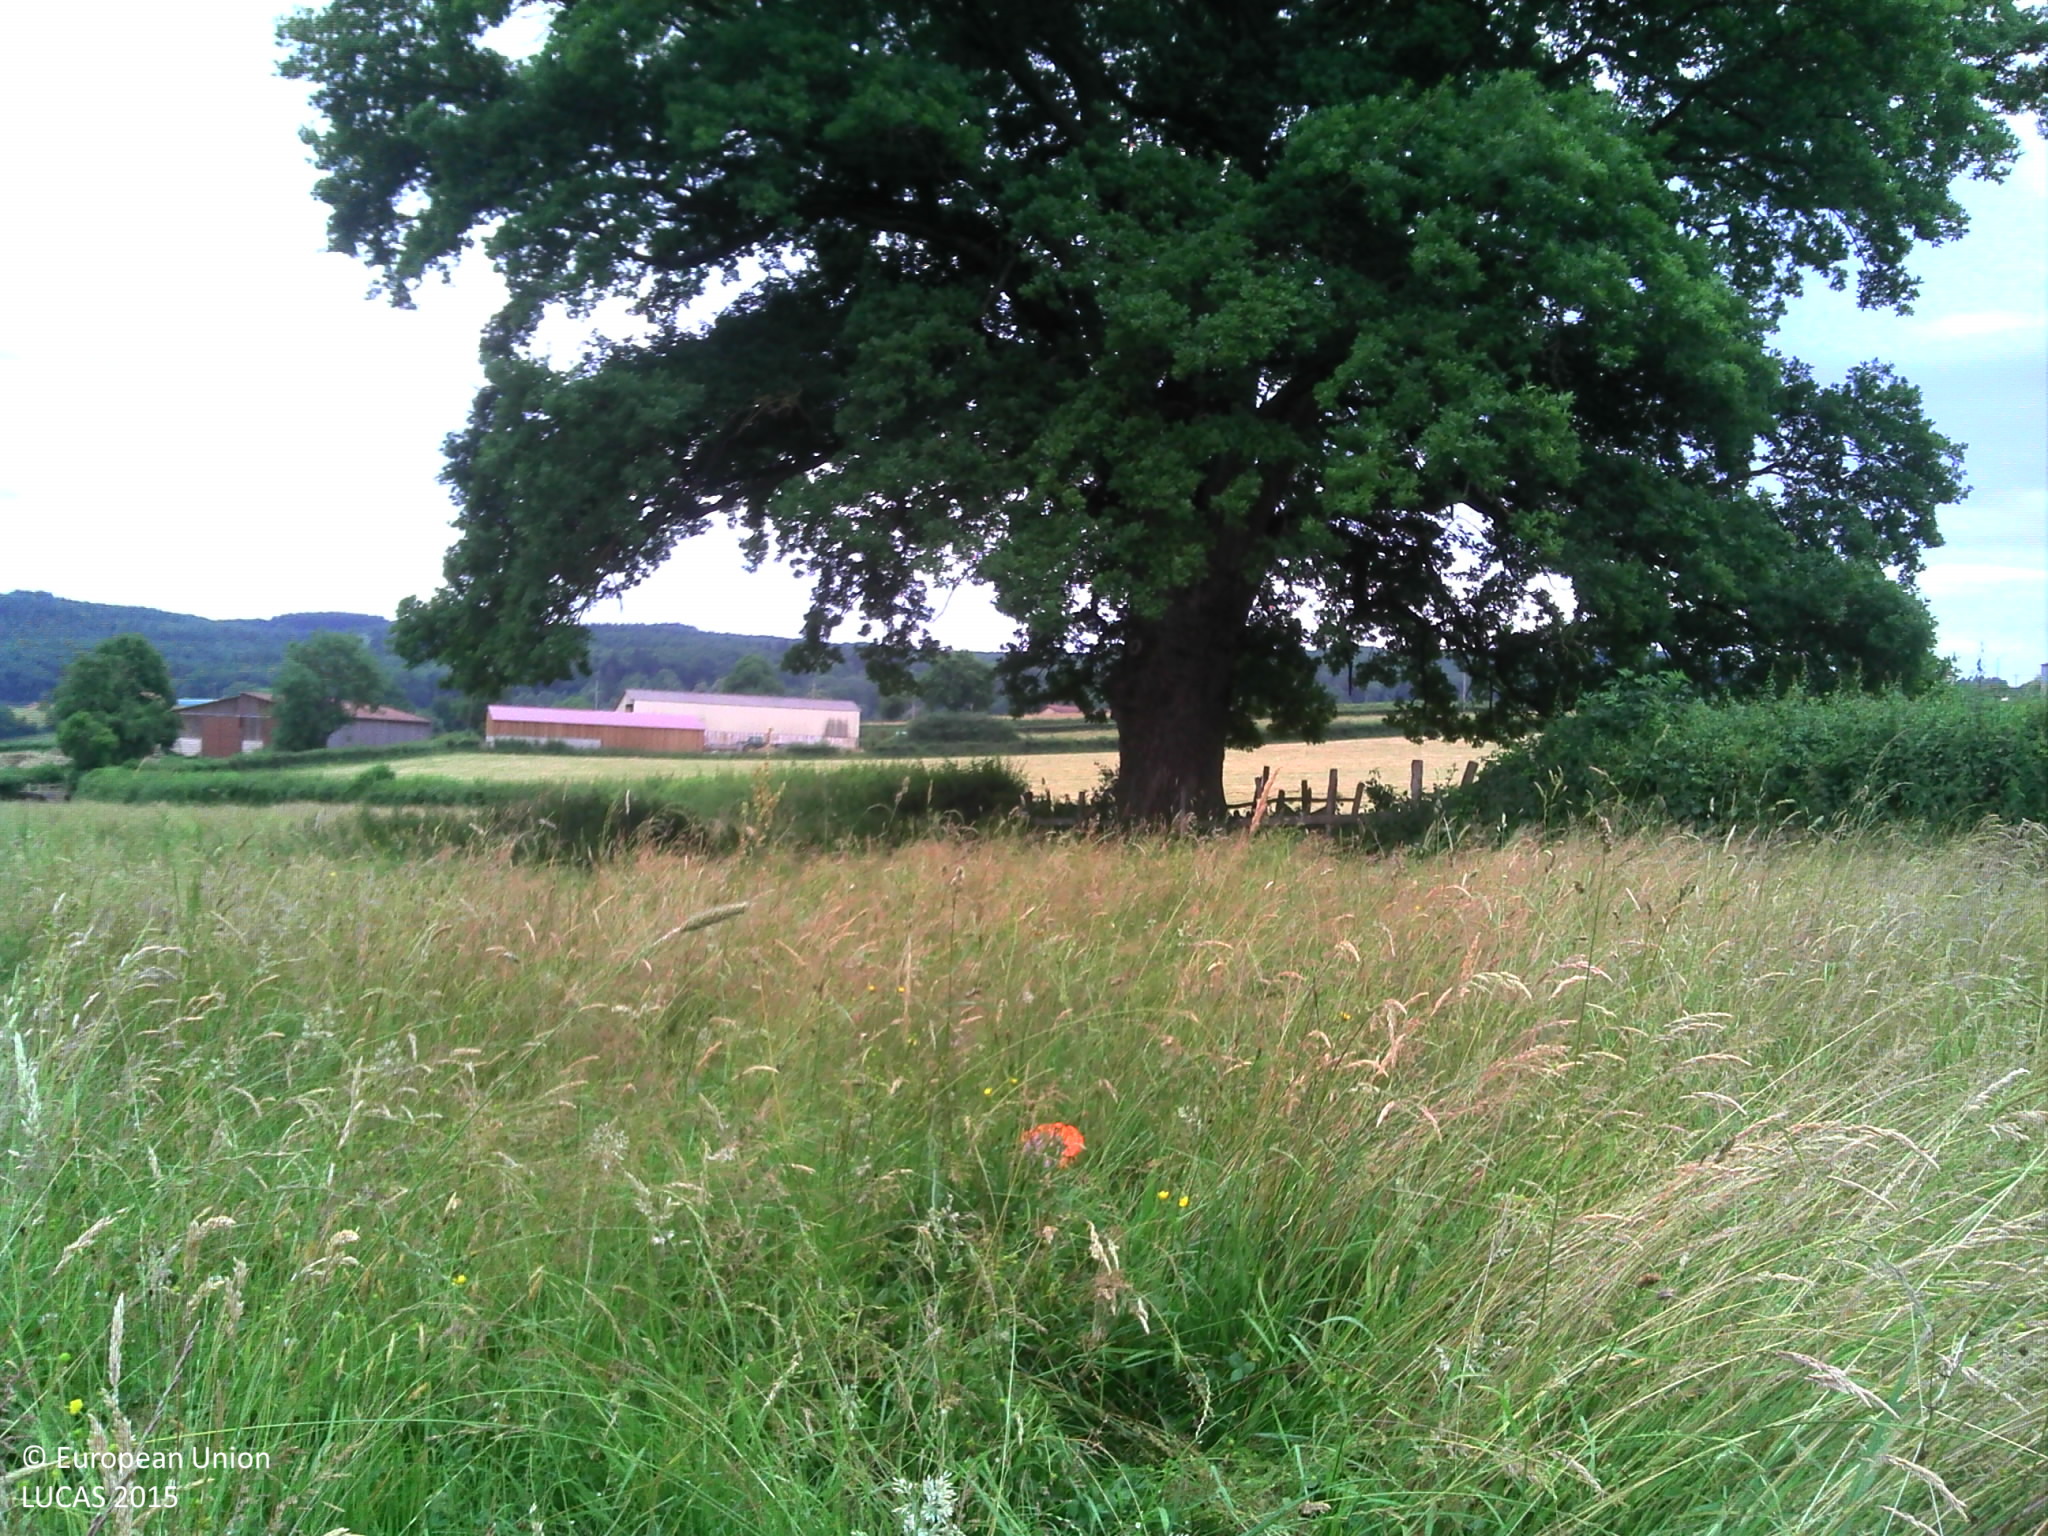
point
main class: Grassland
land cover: Grassland without tree/shrub cover
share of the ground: > 75 %
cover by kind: herbaceous plants 100 %
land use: Agriculture (excluding fallow land and kitchen gardens)
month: June
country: FR
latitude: 46.3570
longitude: 4.5563
